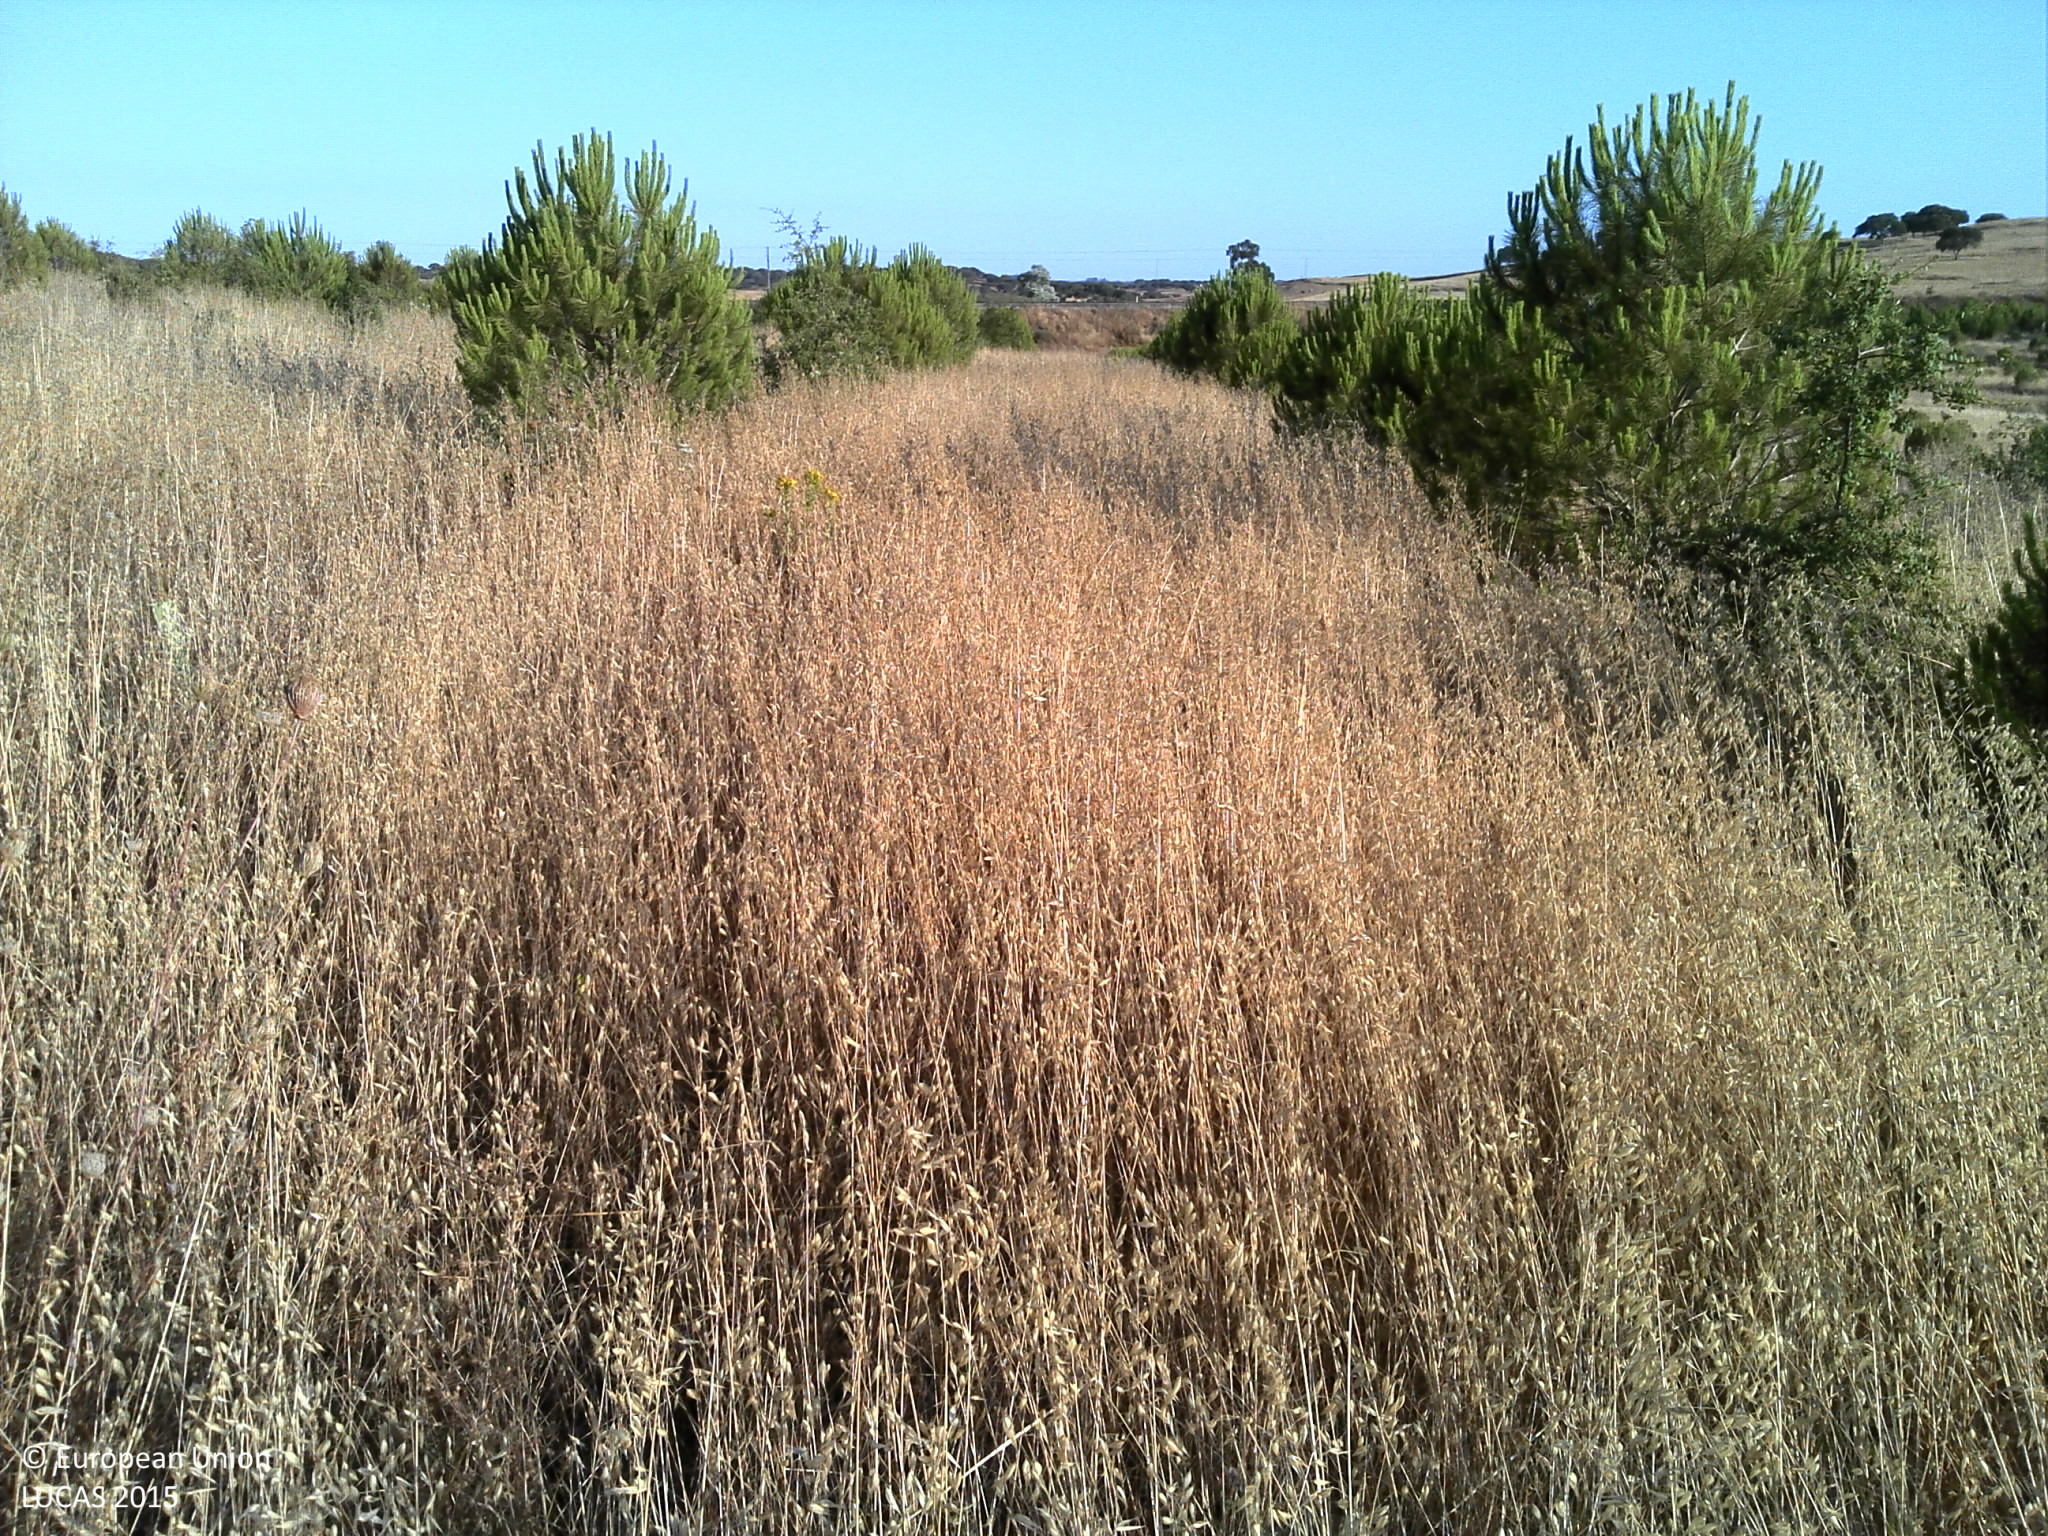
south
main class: Woodland
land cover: Pine dominated mixed woodland
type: coniferous forest of the mediterranean region
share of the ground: 10 - 25 %
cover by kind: herbaceous plants 60 %, coniferous forest trees 15 %, unconsolidated bare surface 15 %, broadleaved forest trees 10 %
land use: Forestry
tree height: < 5 m
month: July
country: PT
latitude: 37.7442
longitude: -8.2459
